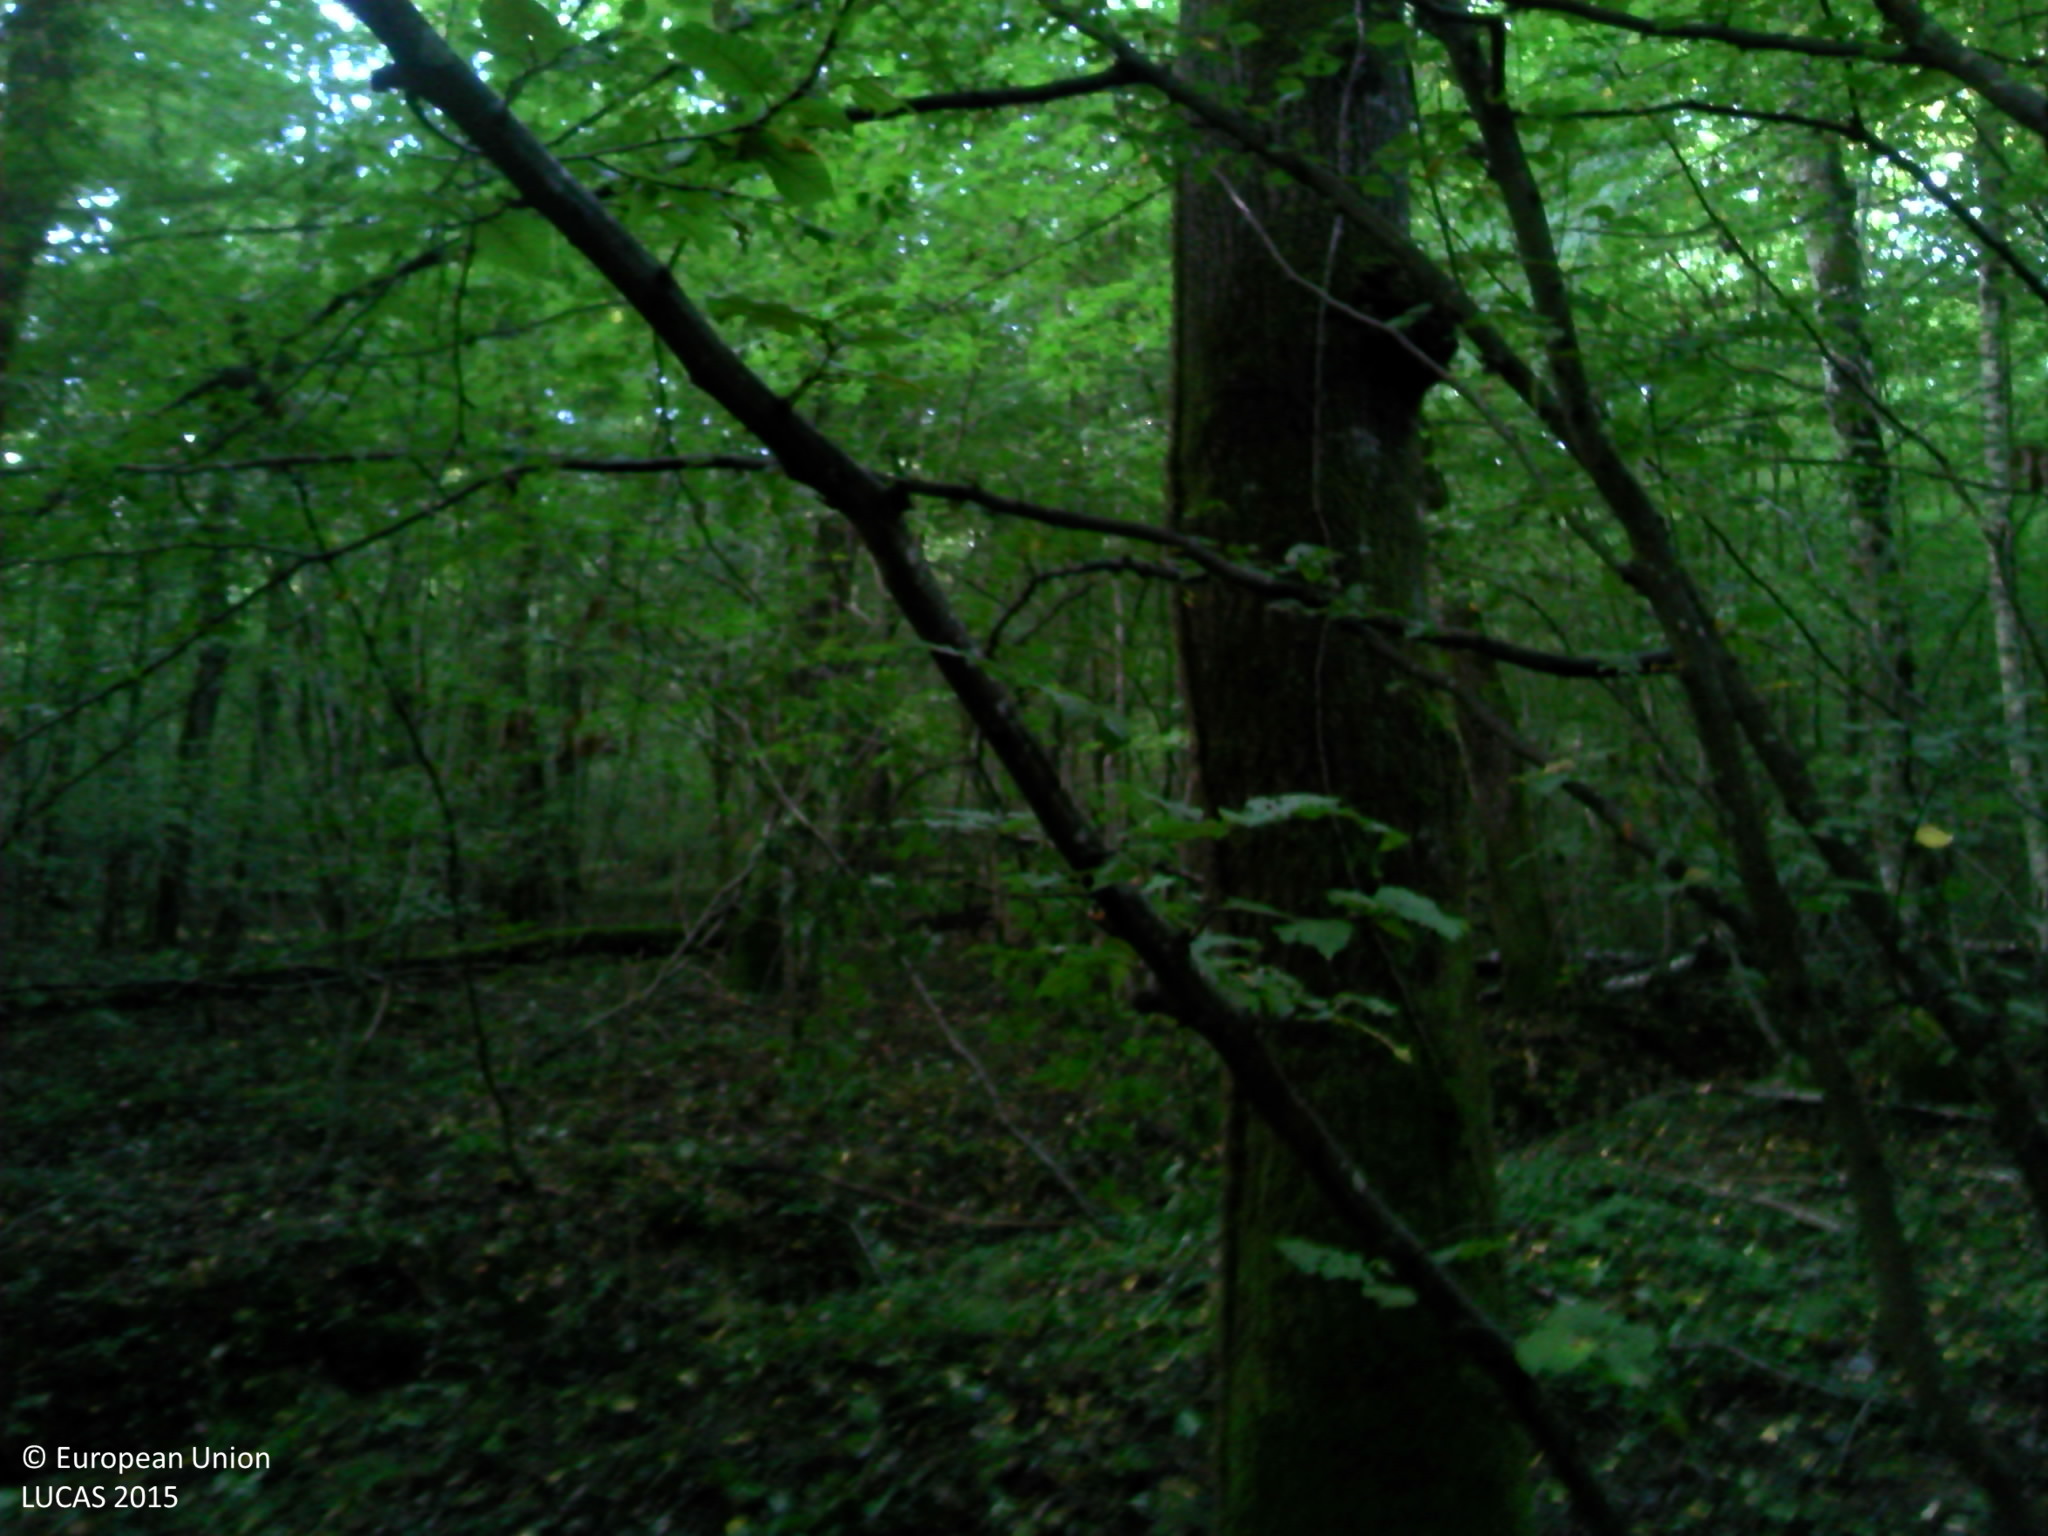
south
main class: Woodland
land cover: Broadleaved woodland
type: mesophytic deciduous forest
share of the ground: > 75 %
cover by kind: broadleaved forest trees 95 %, herbaceous plants 5 %
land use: Forestry
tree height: > 5 m
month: September
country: FR
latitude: 47.0611
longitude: 4.9319
